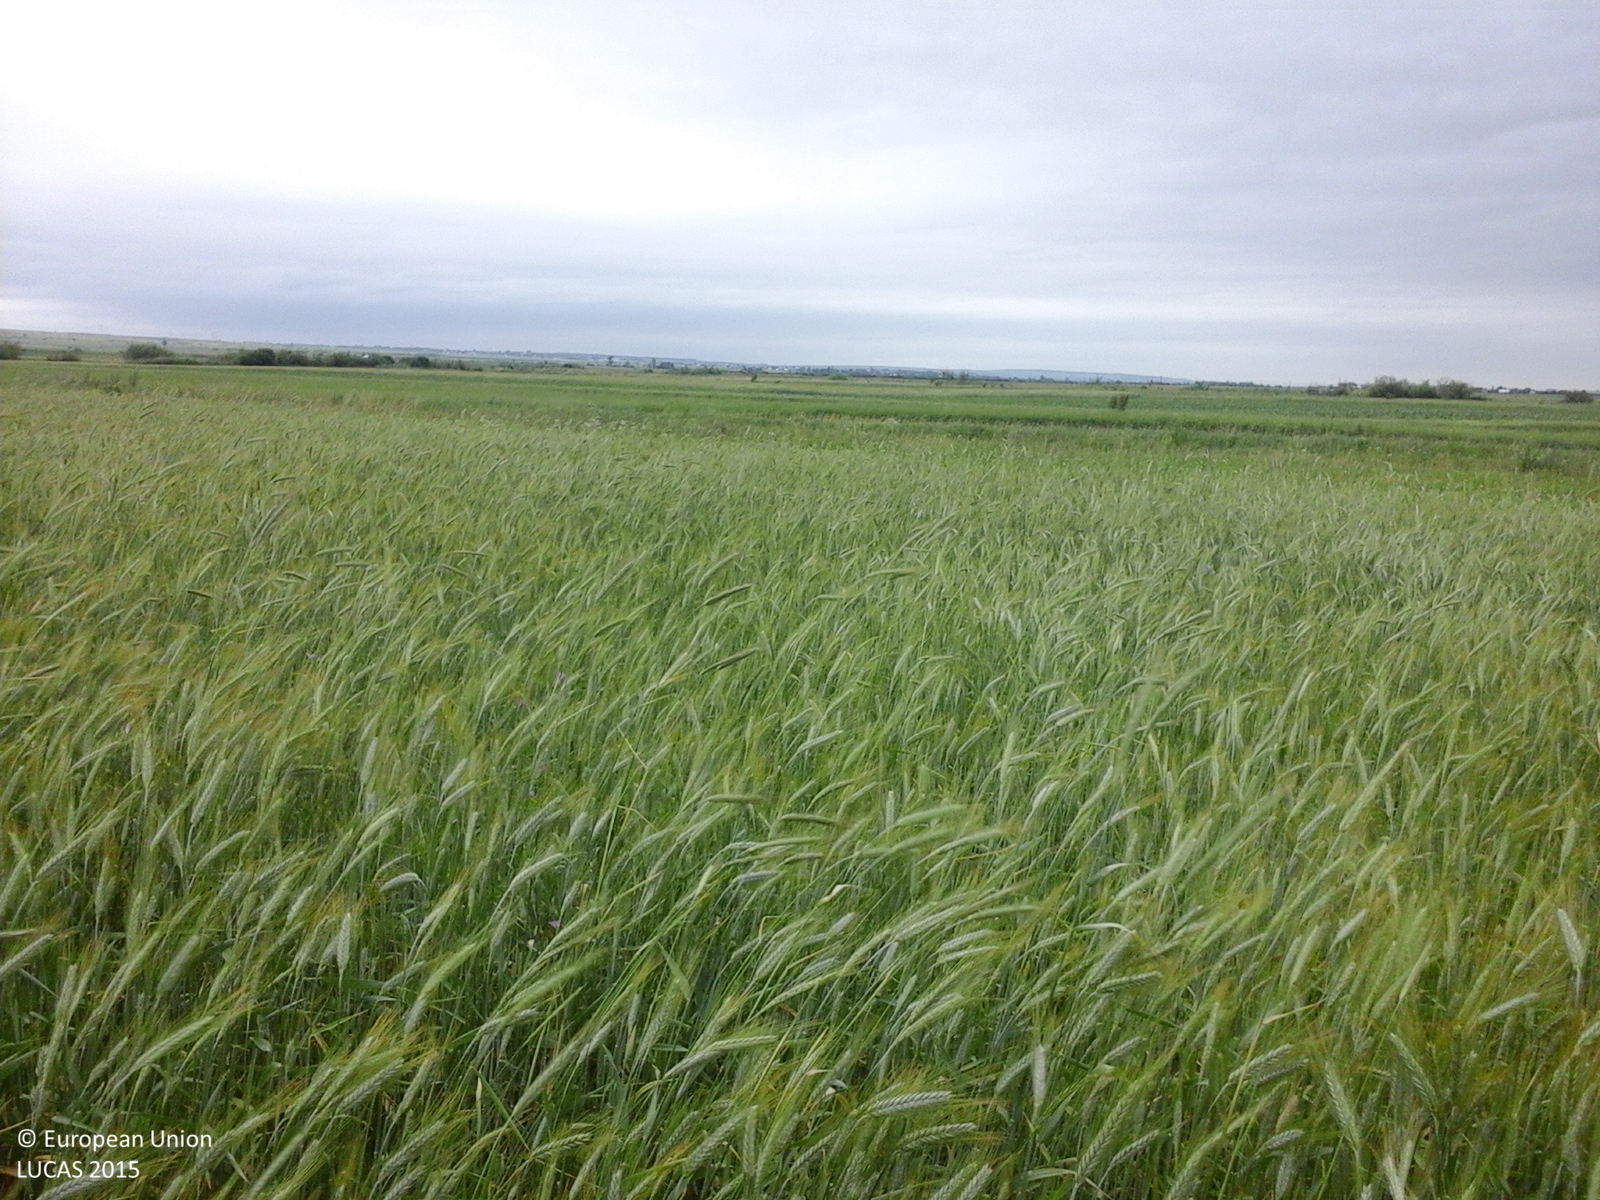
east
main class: Cropland
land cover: Common wheat
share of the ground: > 75 %
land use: Agriculture (excluding fallow land and kitchen gardens)
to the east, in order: Common wheat; Grassland without tree/shrub cover; Tracks; Grass margins; Ditches and canals; Grass margins; Maize; Grassland without tree/shrub cover; Maize; Common wheat; Clovers; Maize; Barley; Grassland without tree/shrub cover; Maize
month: June
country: RO
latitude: 47.4343
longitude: 26.2167
